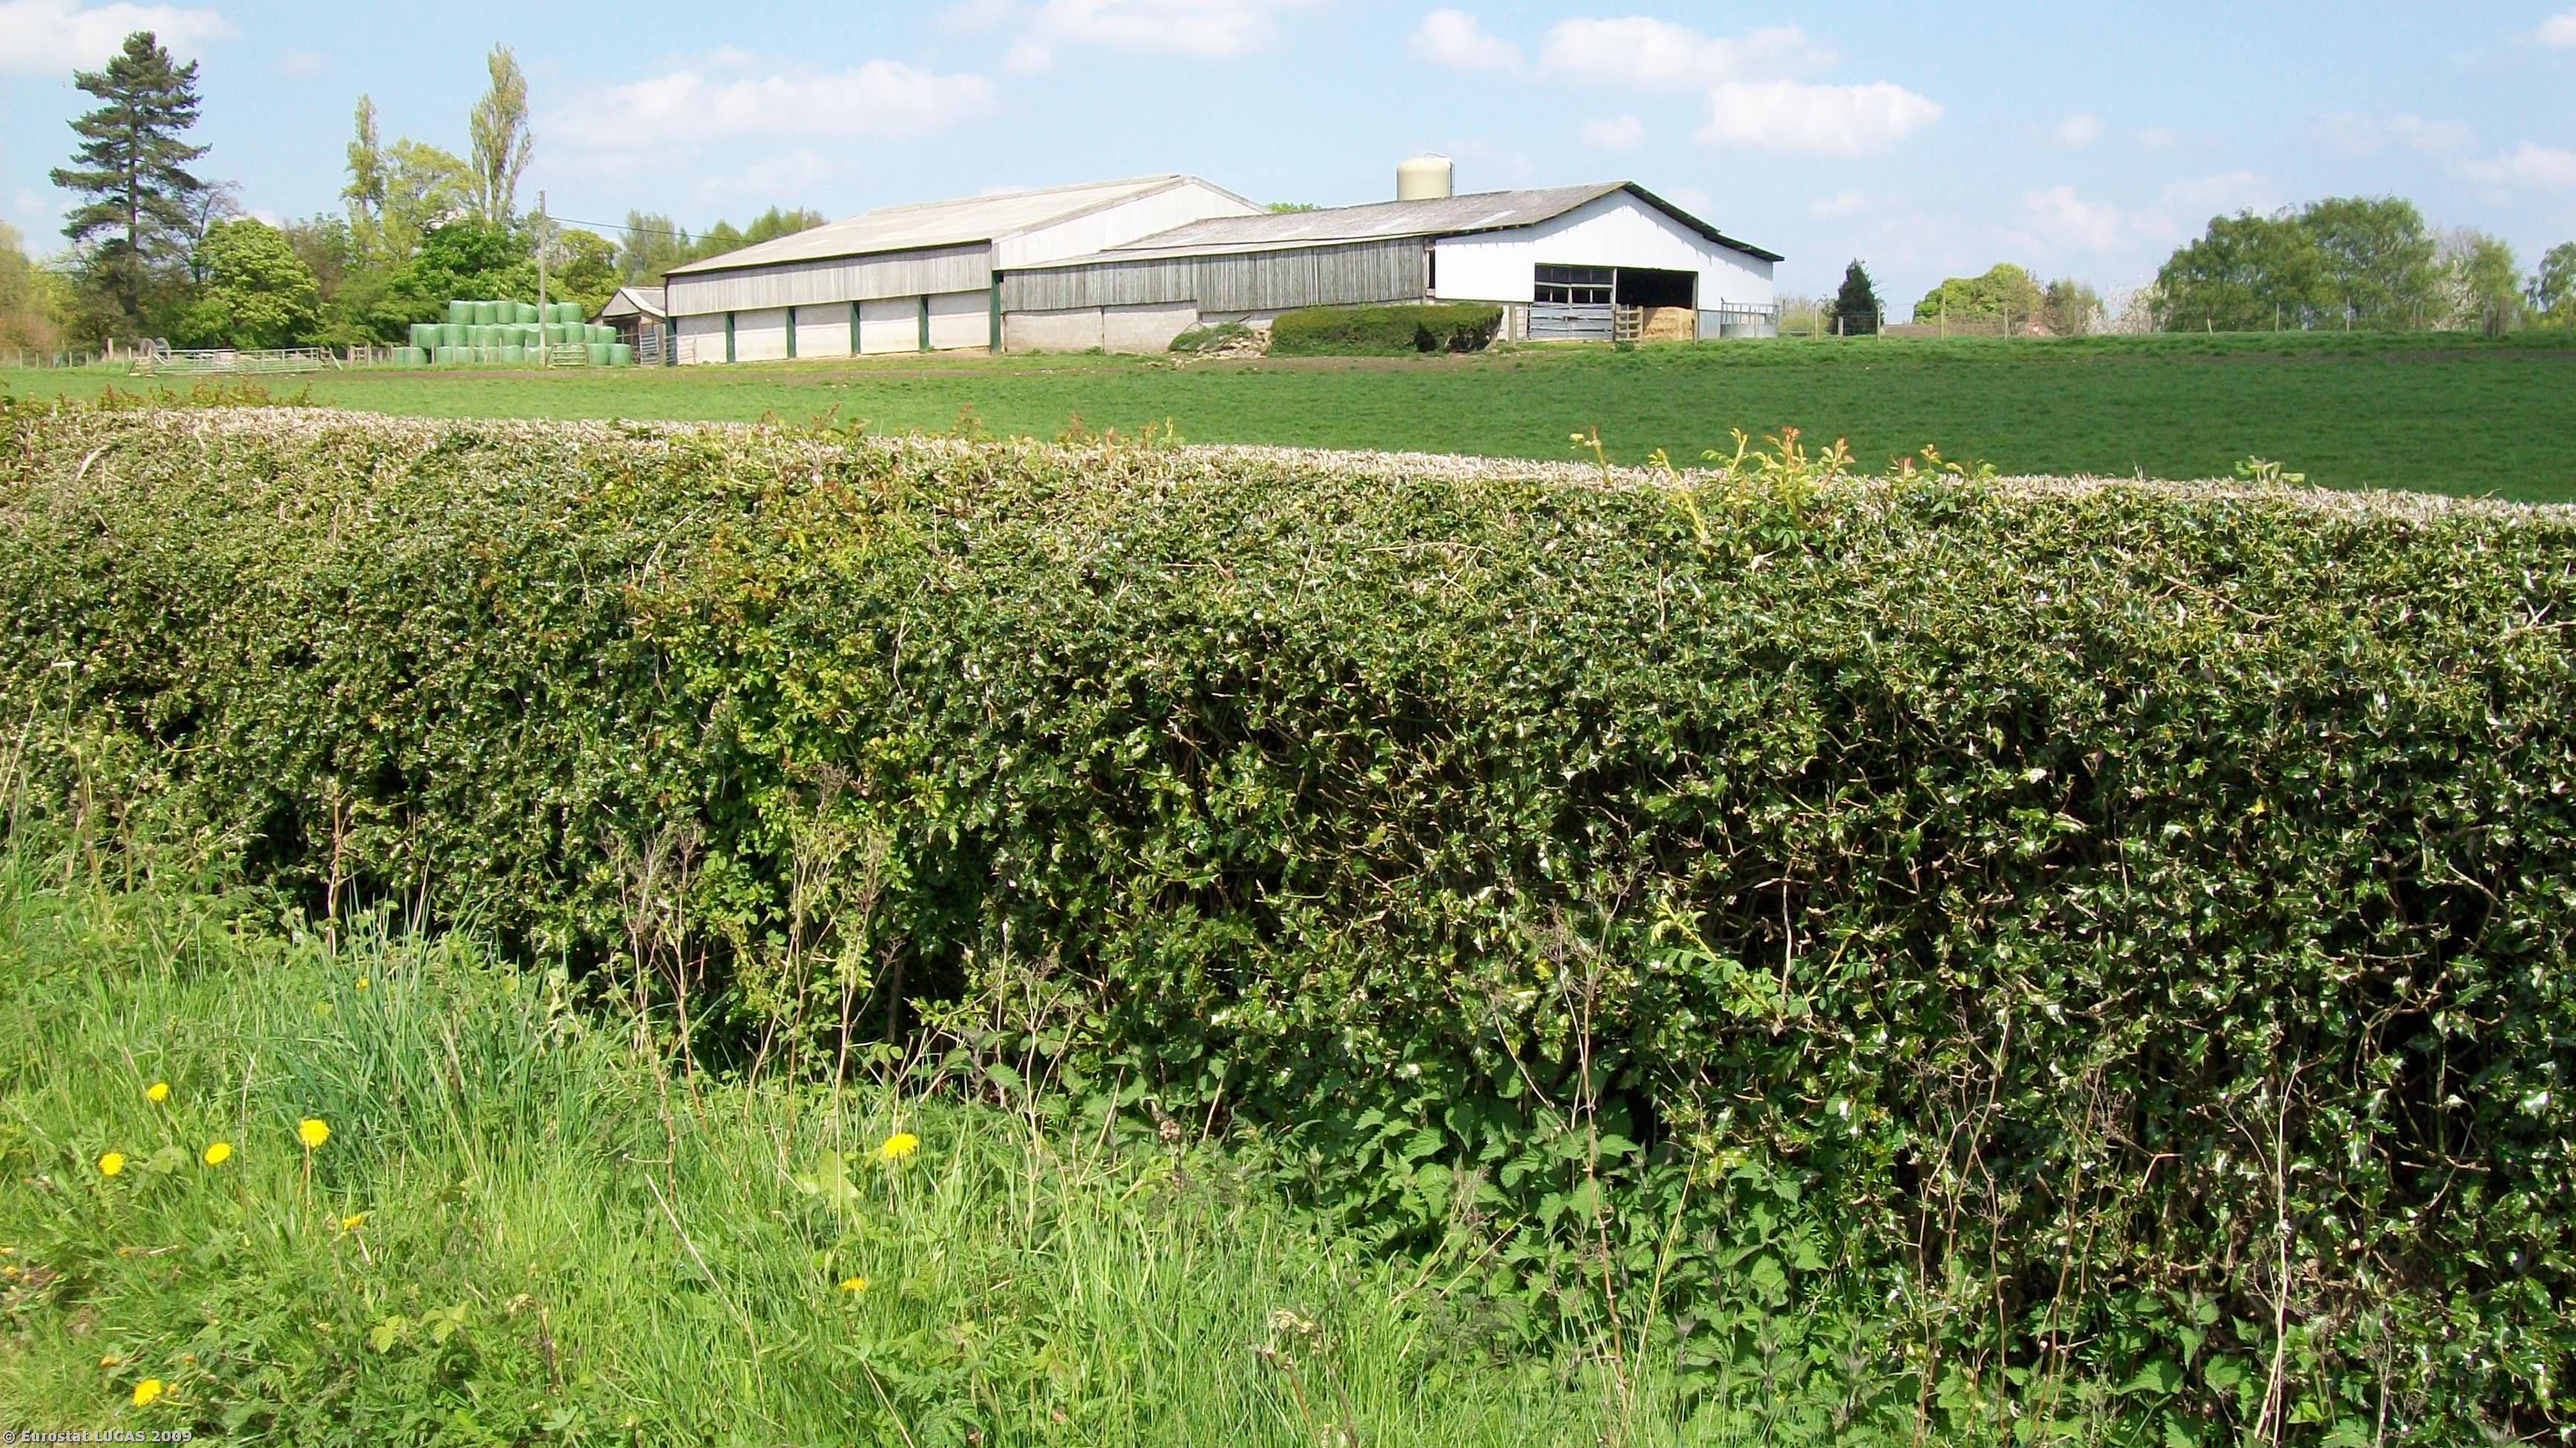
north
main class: Grassland
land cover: Grassland without tree/shrub cover
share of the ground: 25 - 50 %
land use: Agriculture (excluding fallow land and kitchen gardens)
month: April
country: GB
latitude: 53.1113
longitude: -1.4483
